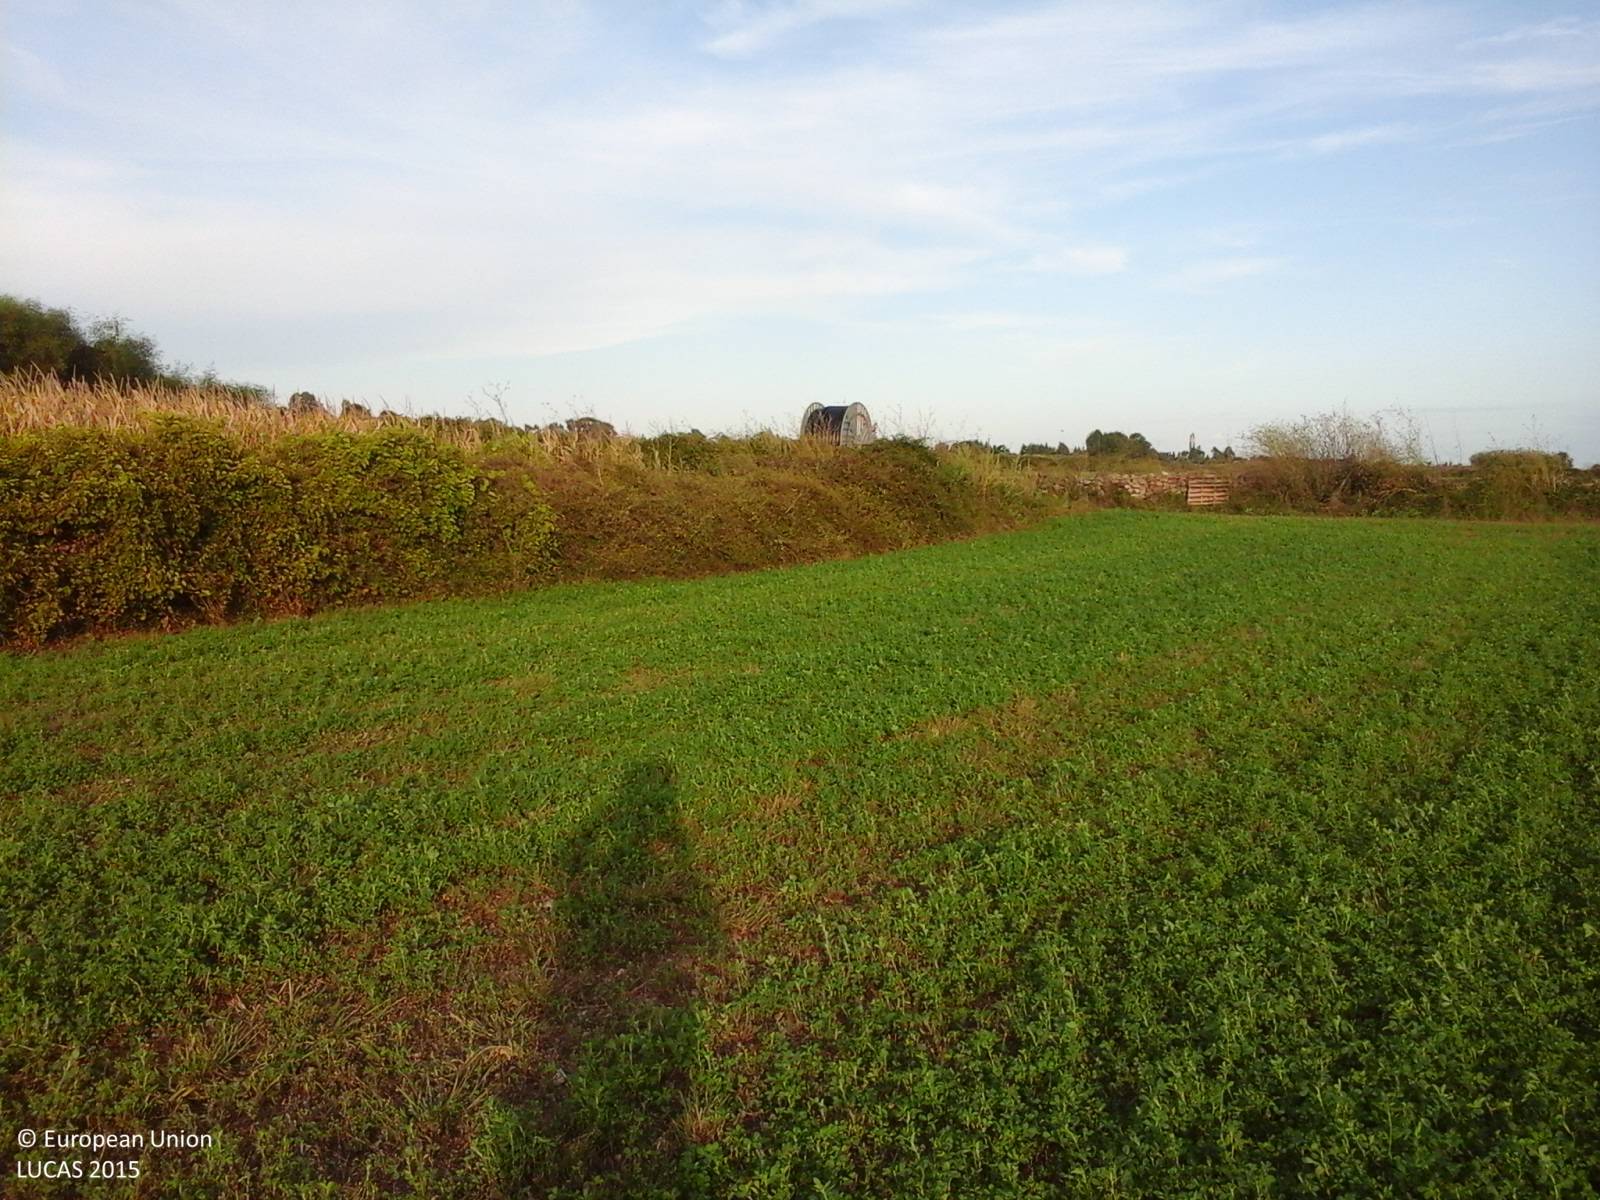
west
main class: Cropland
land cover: Lucerne
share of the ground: > 75 %
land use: Agriculture (excluding fallow land and kitchen gardens)
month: September
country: IT
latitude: 40.0023
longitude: 8.4971
